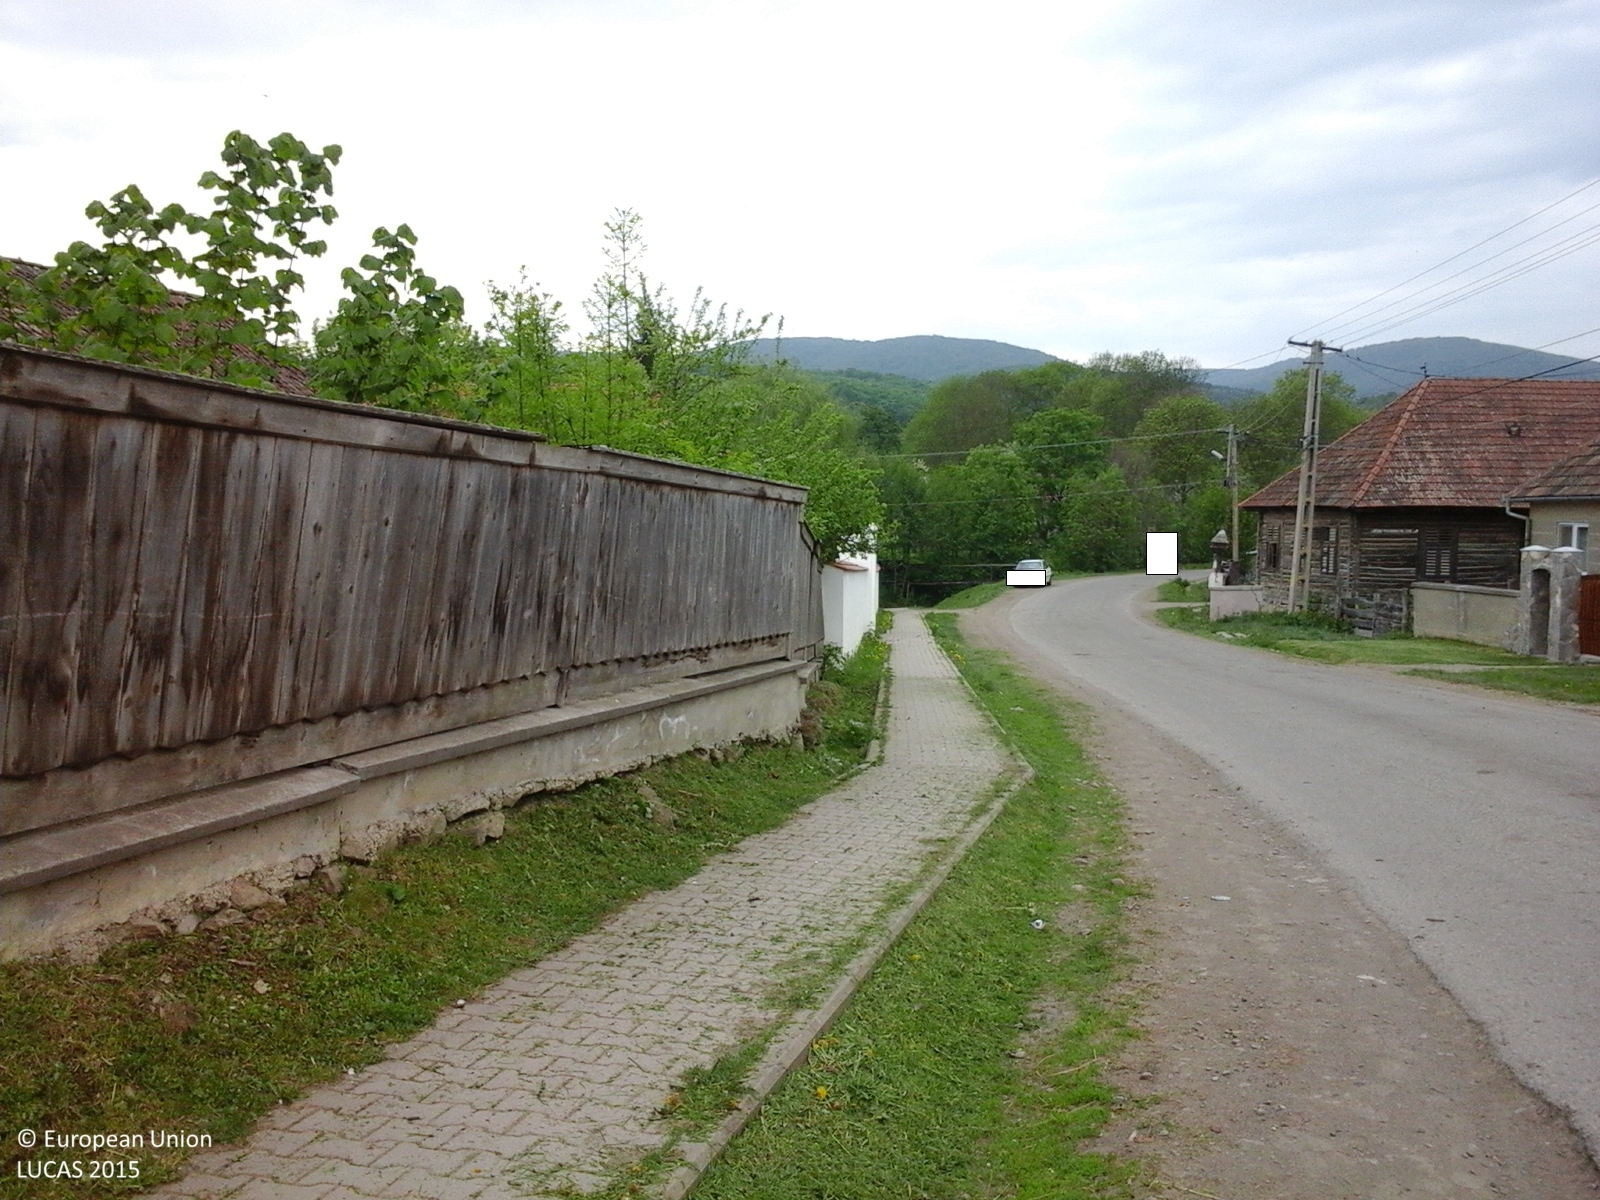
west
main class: Cropland
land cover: Apple fruit
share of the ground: 25 - 50 %
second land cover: Grassland without tree/shrub cover
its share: > 75 %
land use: Kitchen garden
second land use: Residential
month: May
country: RO
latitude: 45.9799
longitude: 26.0065
